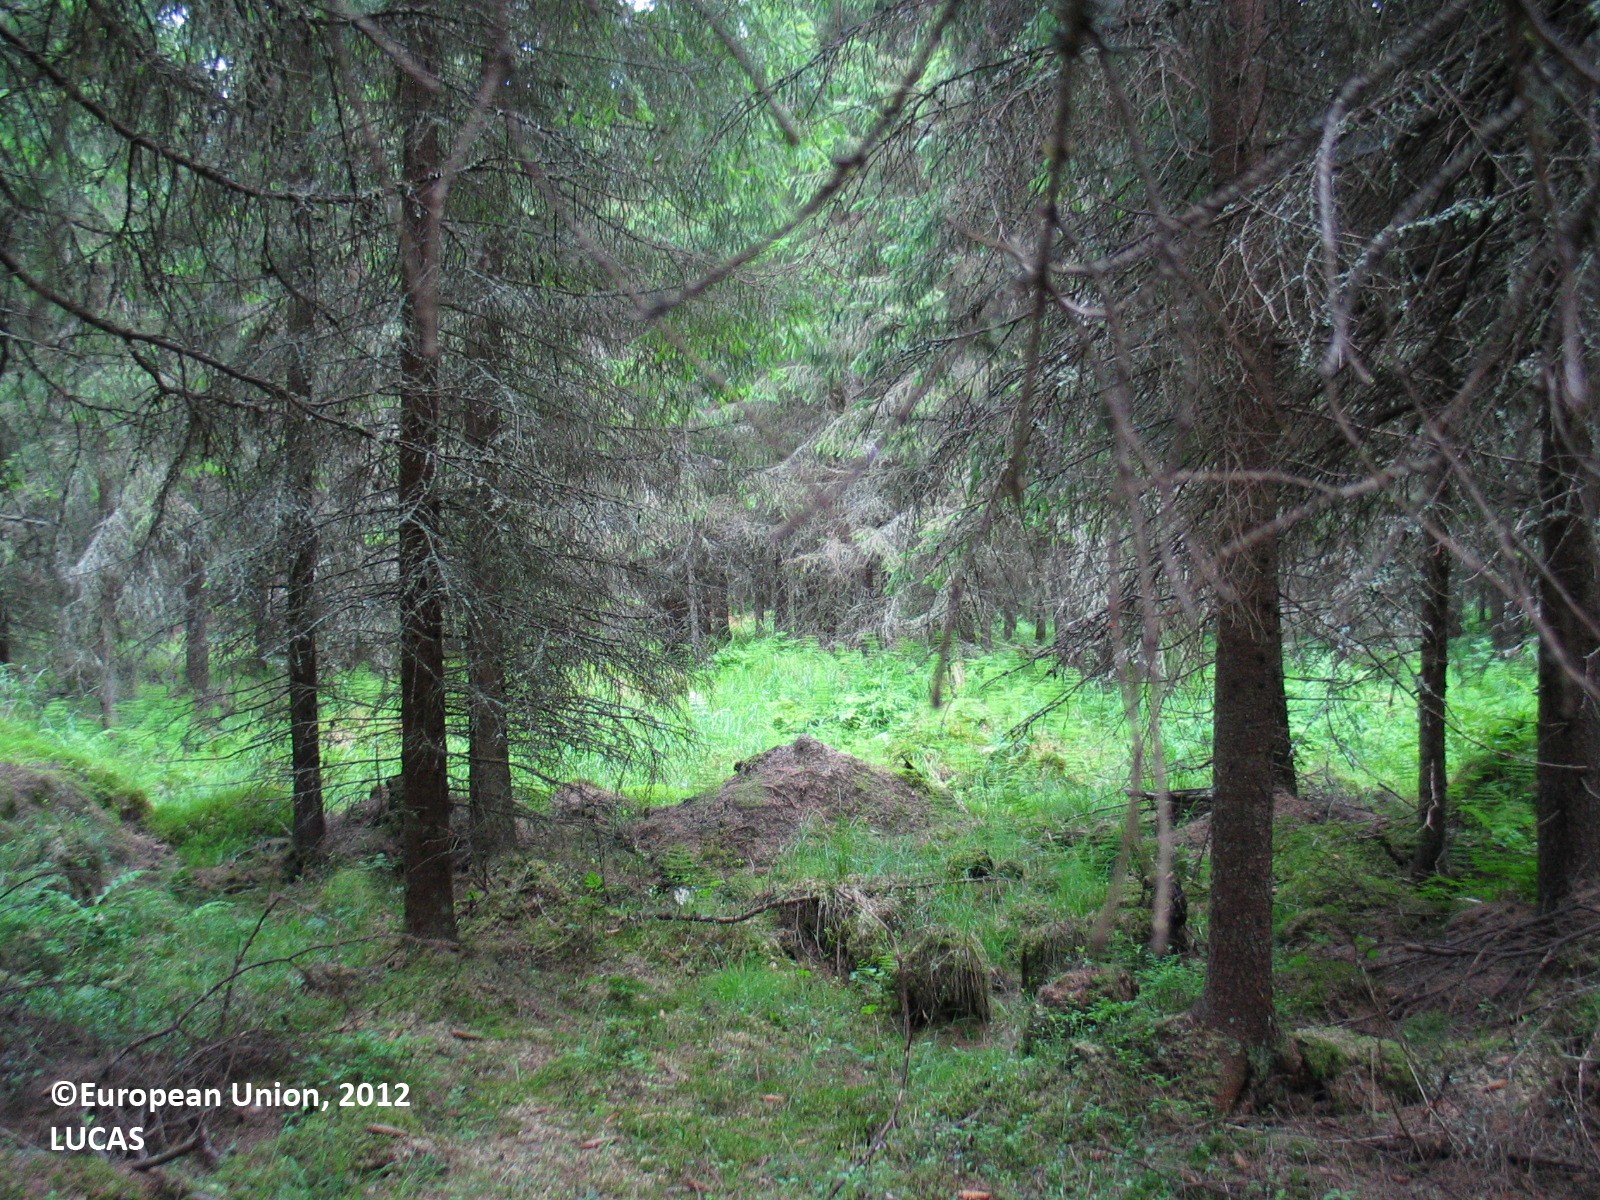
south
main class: Woodland
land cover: Spruce dominated coniferous woodland
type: mire and swamp forests
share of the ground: 50 - 75 %
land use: Forestry
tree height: > 5 m
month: July
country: FI
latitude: 65.6482
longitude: 25.0853
